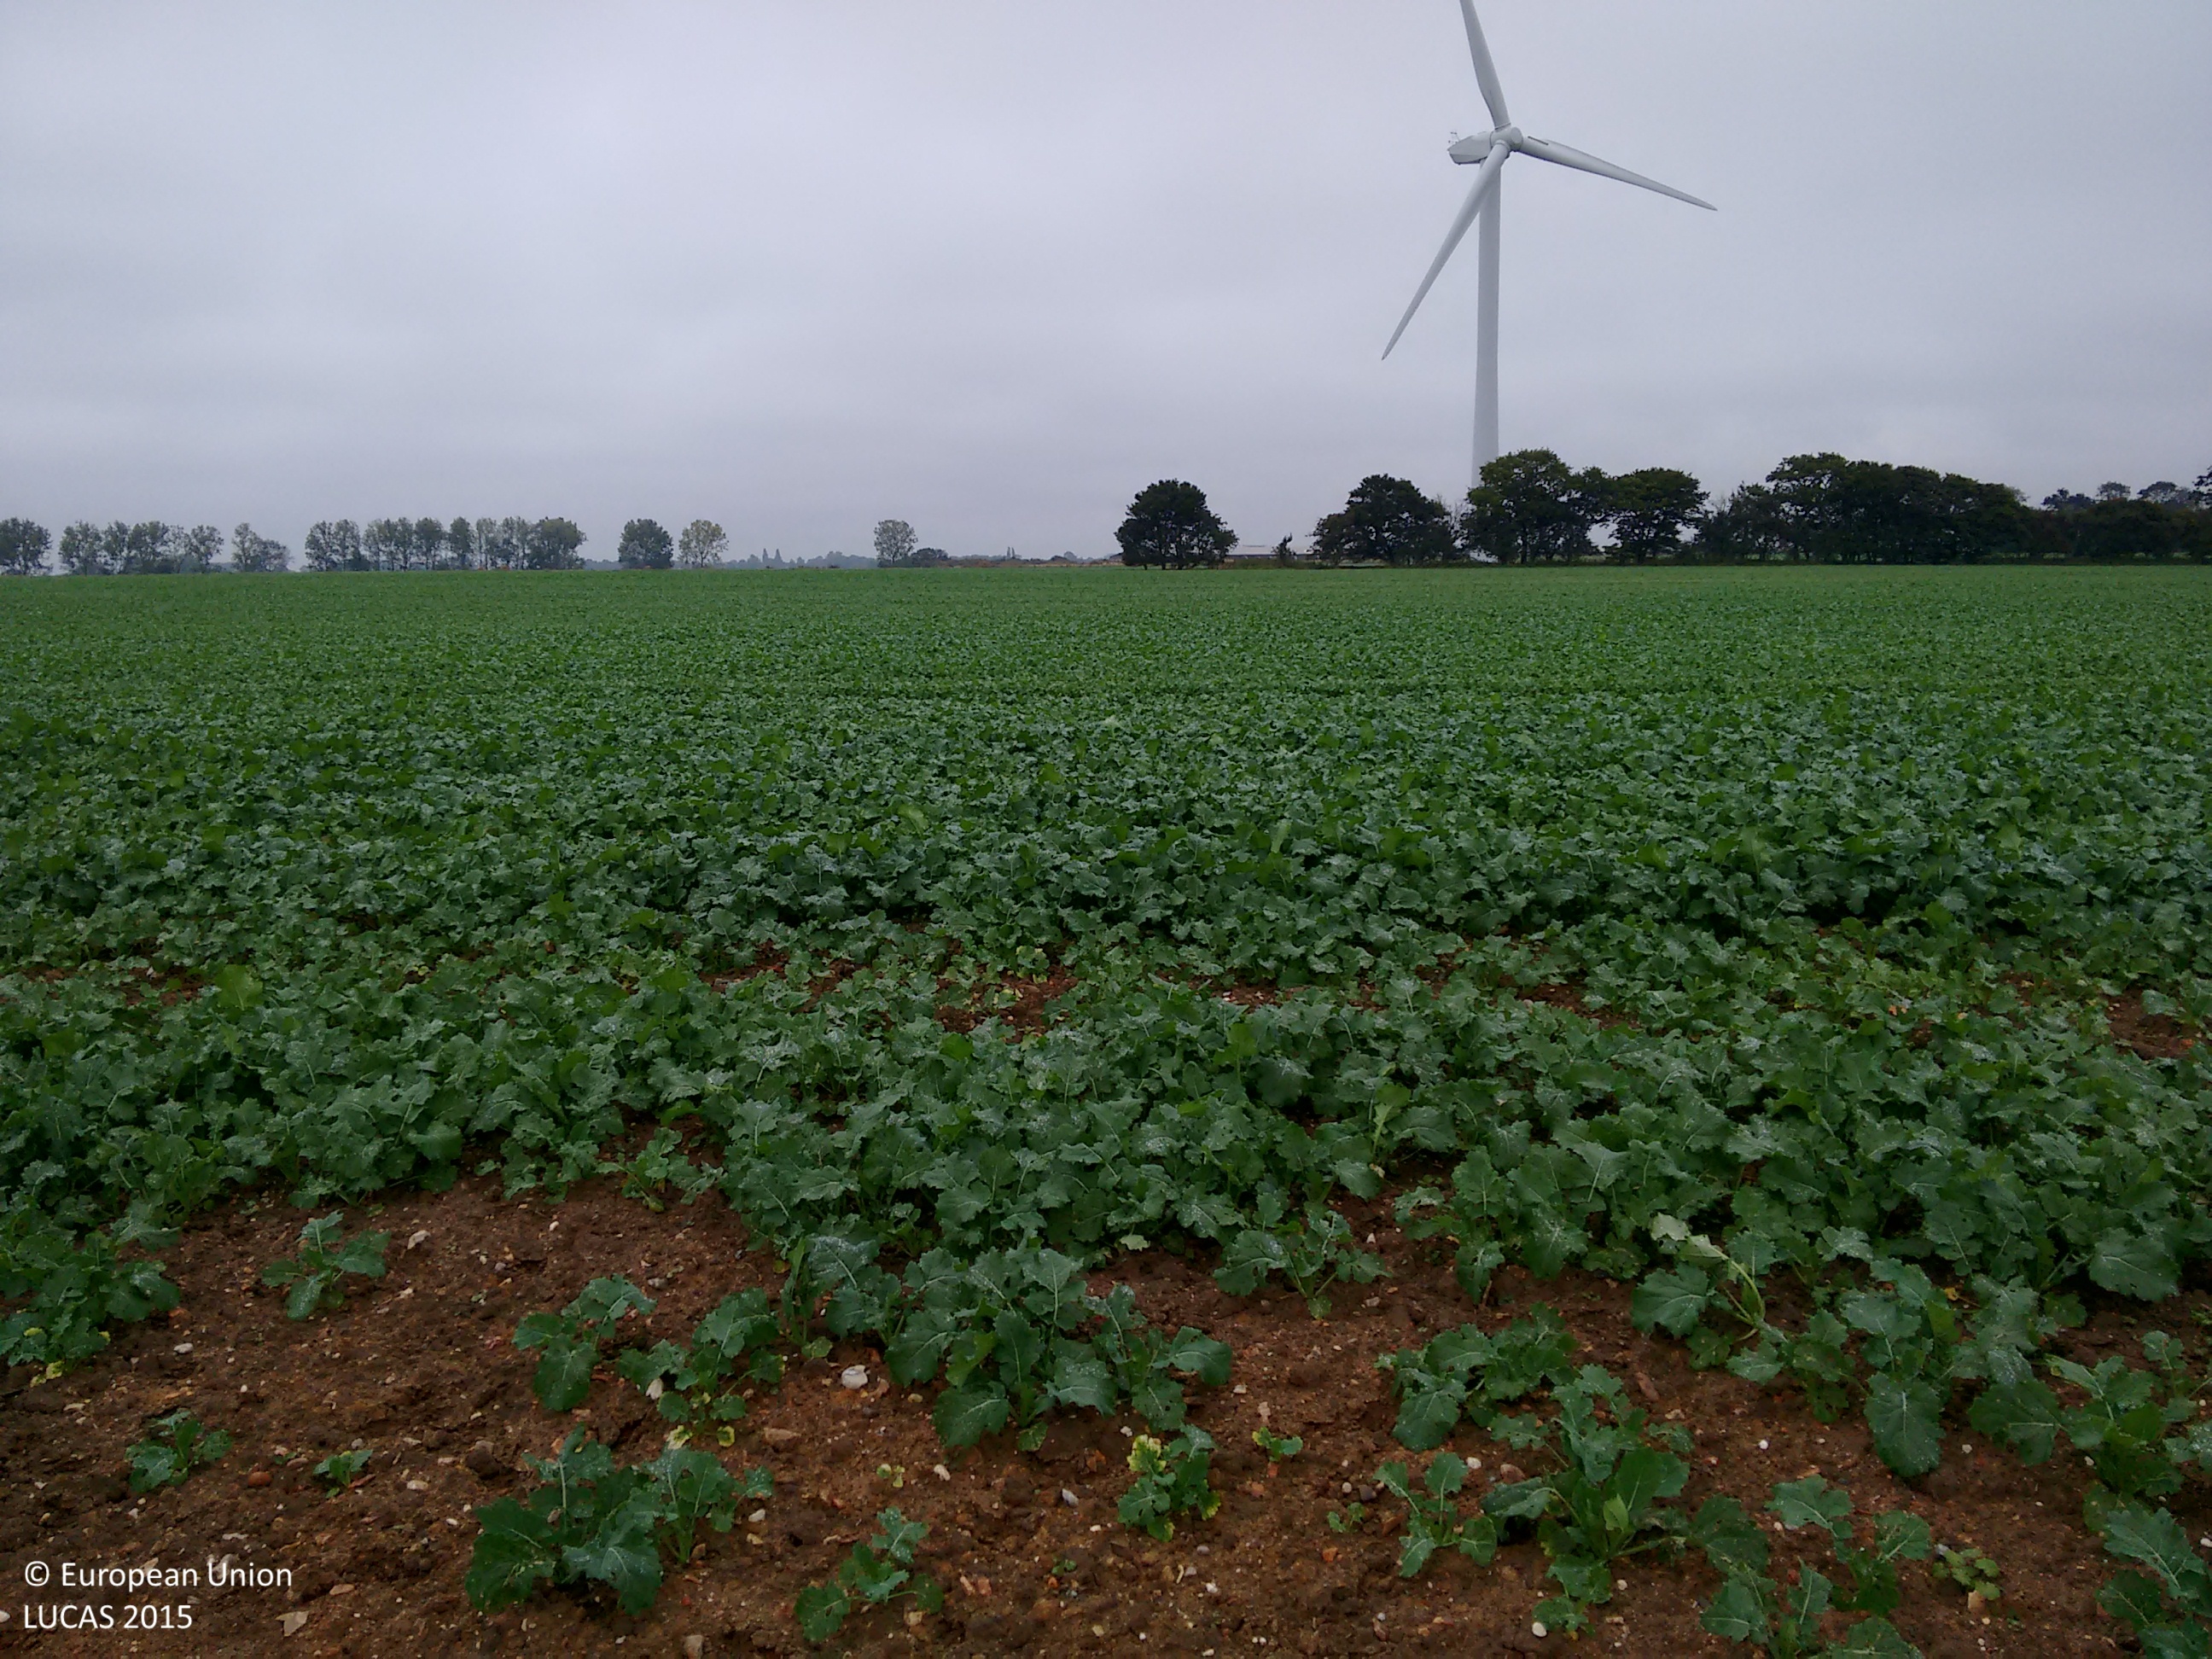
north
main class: Cropland
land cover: Rape and turnip rape
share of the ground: > 75 %
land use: Agriculture (excluding fallow land and kitchen gardens)
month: October
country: GB
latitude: 52.3642
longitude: 1.5370
